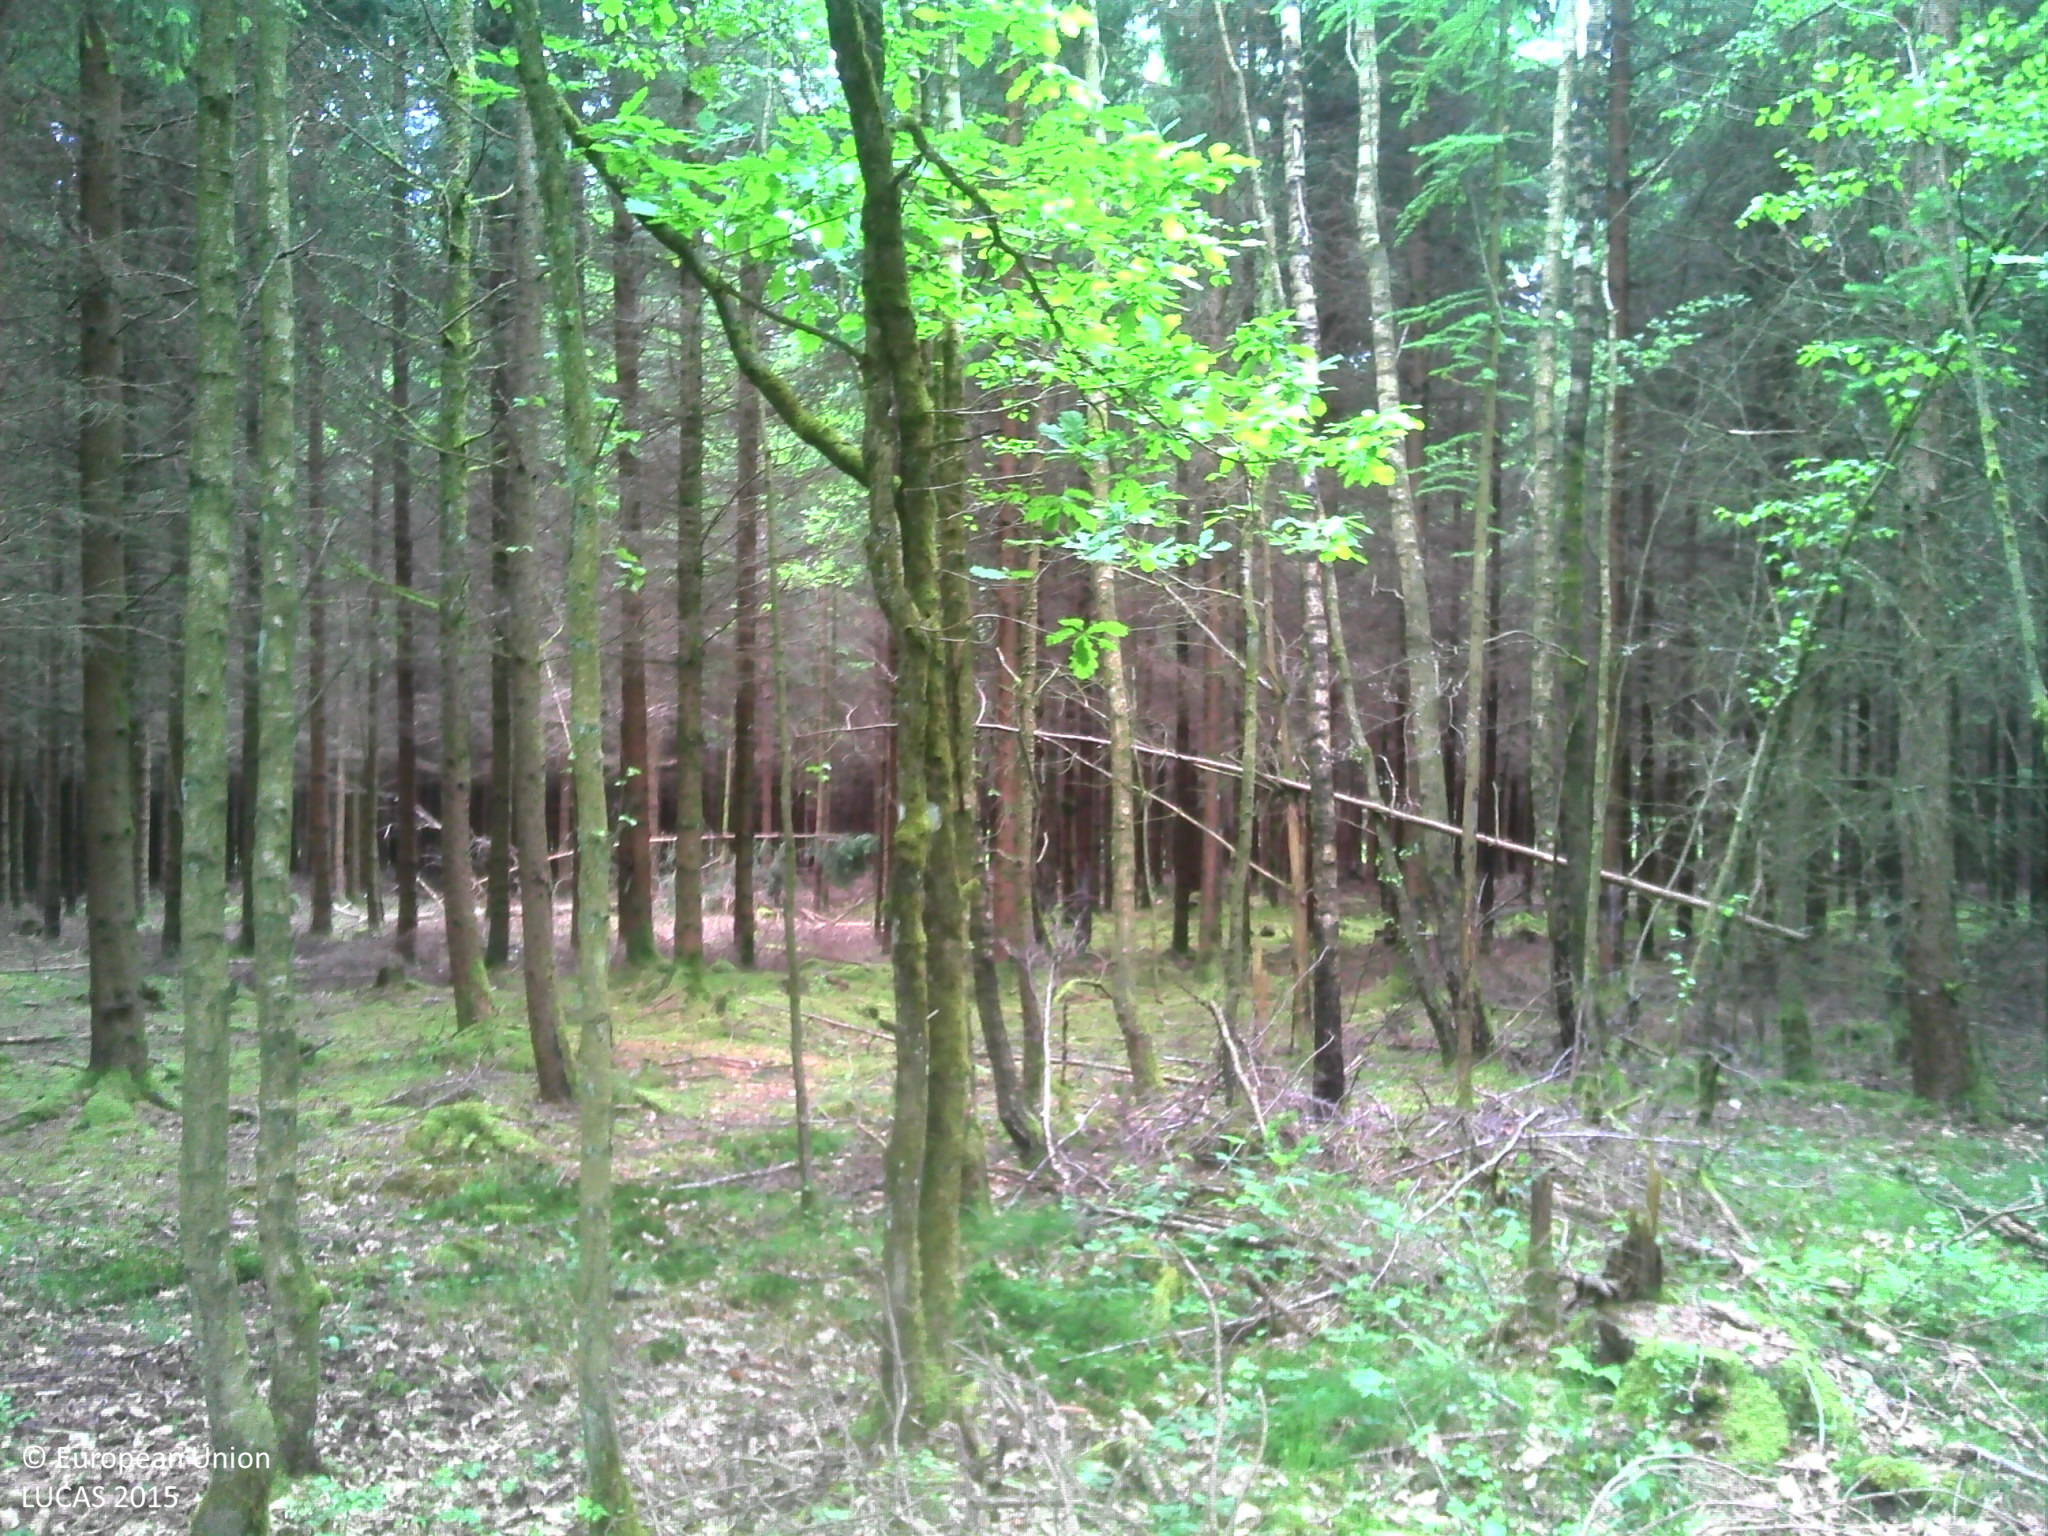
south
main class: Woodland
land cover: Pine dominated mixed woodland
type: hemiboreal forest and nemoral coniferous forest and mixed broadleaved-coniferous forest
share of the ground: > 75 %
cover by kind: broadleaved forest trees 50 %, coniferous forest trees 40 %, herbaceous plants 10 %
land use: Forestry
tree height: > 5 m
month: June
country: BE
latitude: 50.0534
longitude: 4.9272
